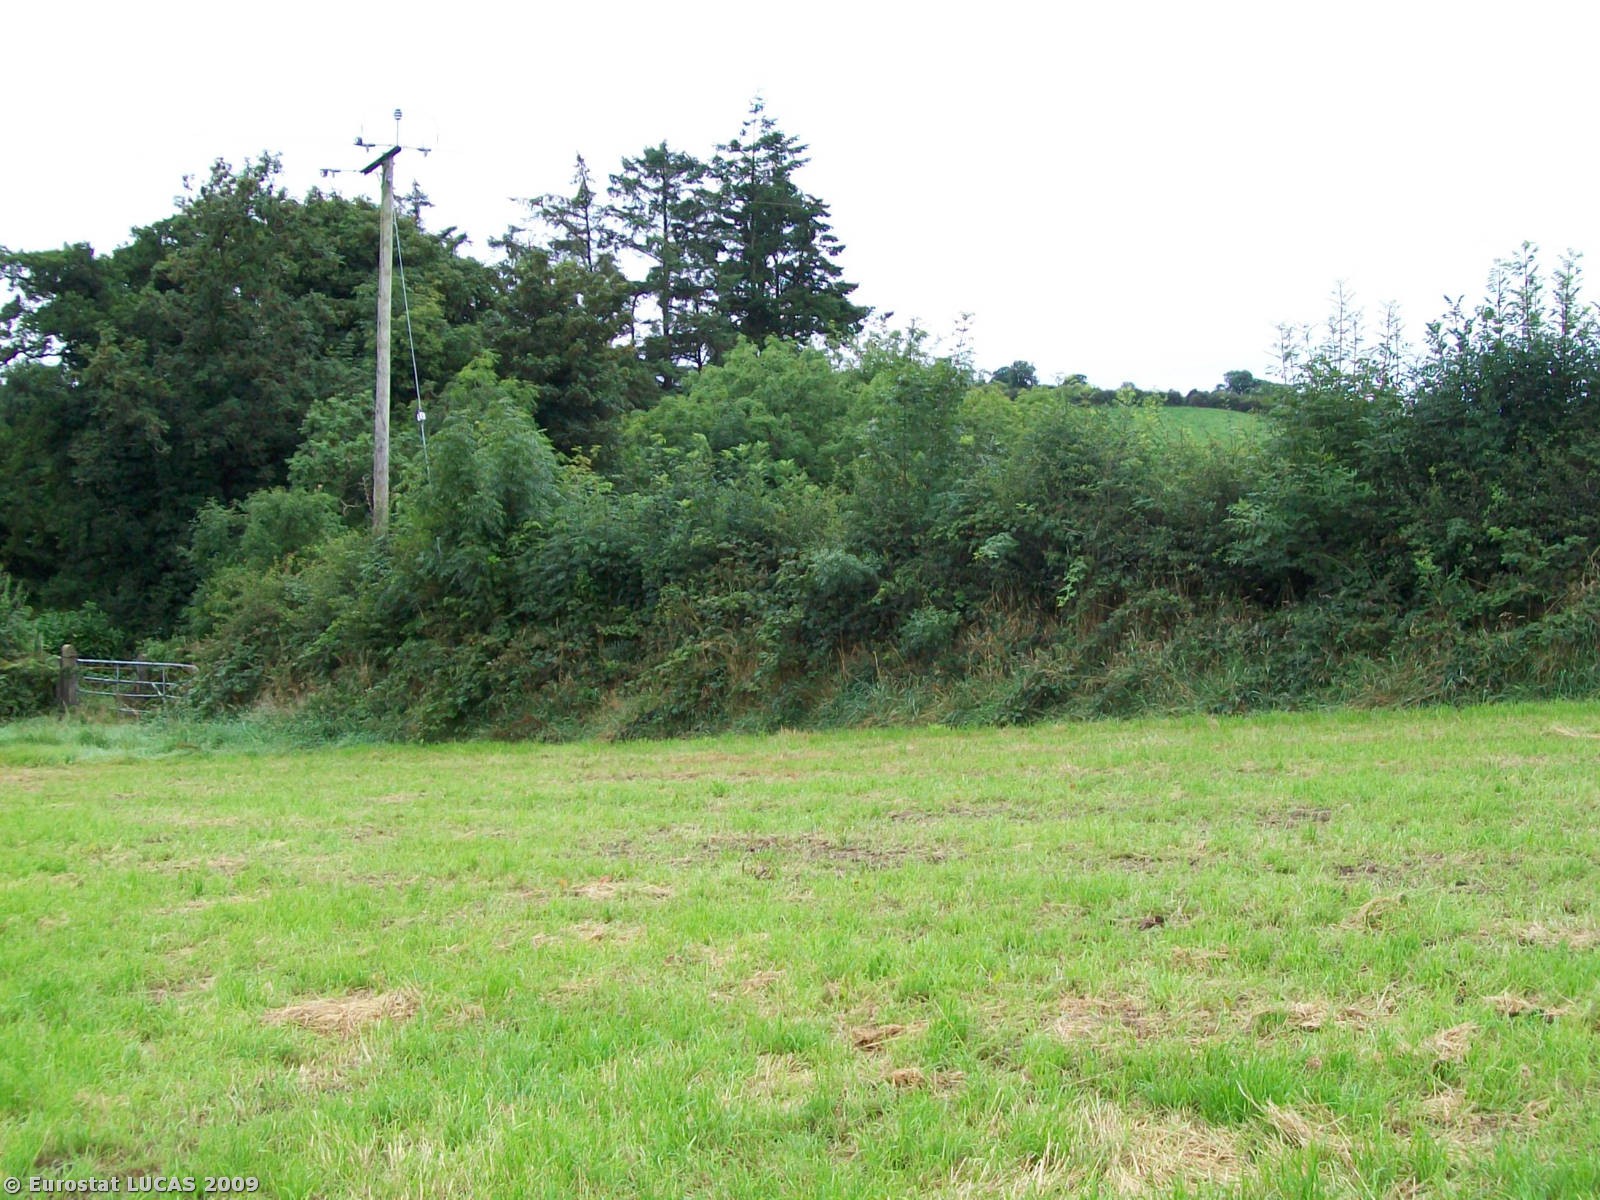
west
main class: Grassland
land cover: Grassland without tree/shrub cover
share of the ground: > 75 %
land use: Agriculture (excluding fallow land and kitchen gardens)
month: August
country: GB
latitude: 54.0585
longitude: -6.6443
